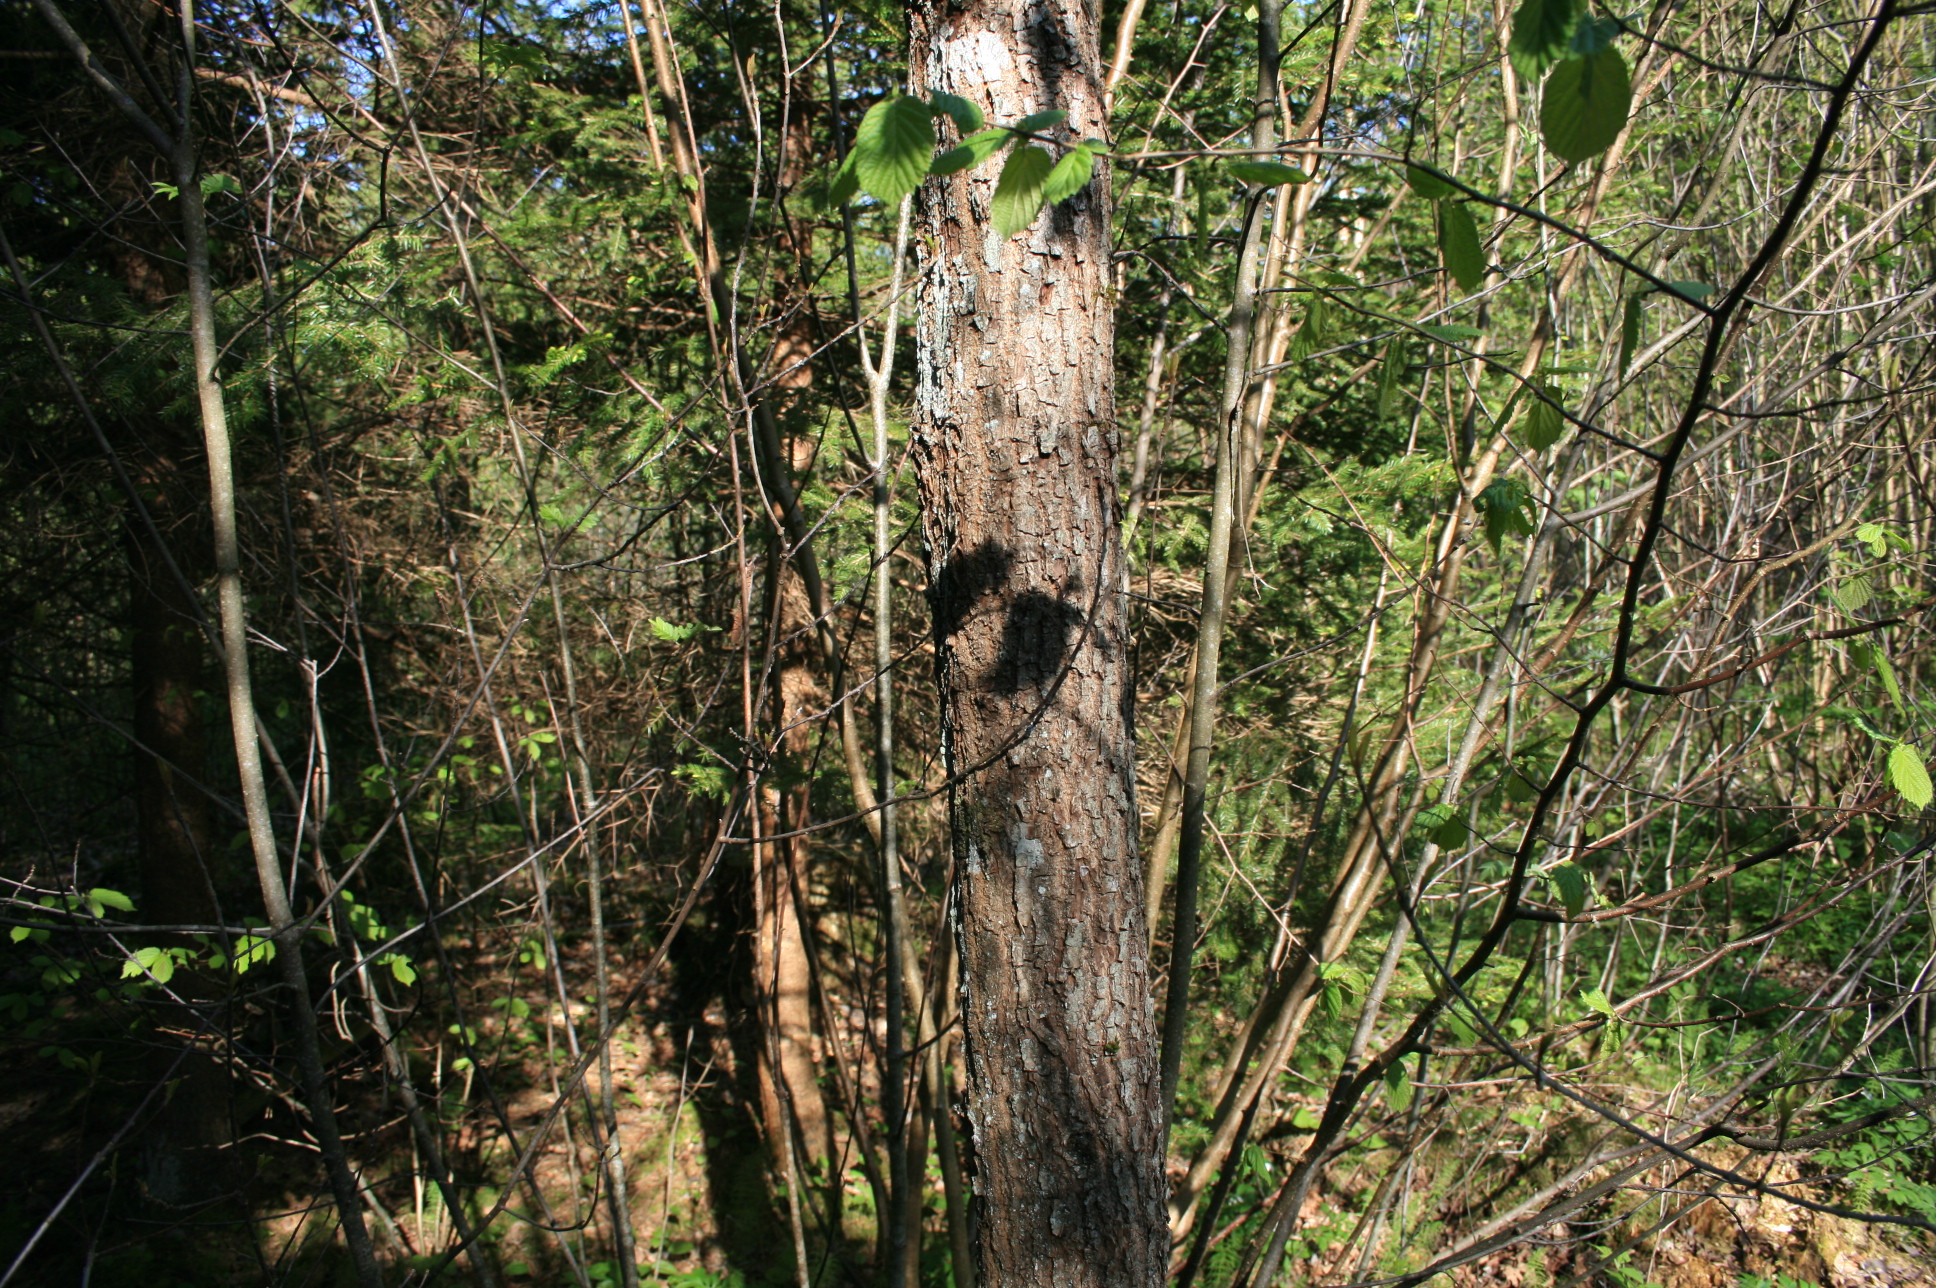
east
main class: Woodland
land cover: Other mixed woodland
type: hemiboreal forest and nemoral coniferous forest and mixed broadleaved-coniferous forest
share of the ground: > 75 %
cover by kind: coniferous forest trees 70 %, broadleaved forest trees 25 %, lichens and mosses 5 %
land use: Forestry
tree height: > 5 m
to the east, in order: Other mixed woodland; Broadleaved woodland; Spontaneously vegetated surfaces; Grassland without tree/shrub cover; Paved roads, cycling and walking lanes; Grass margins; Abandoned hedges; Ditches and canals; Broadleaved woodland; Spruce dominated mixed woodland
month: May
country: LT
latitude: 55.9805
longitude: 21.4708
